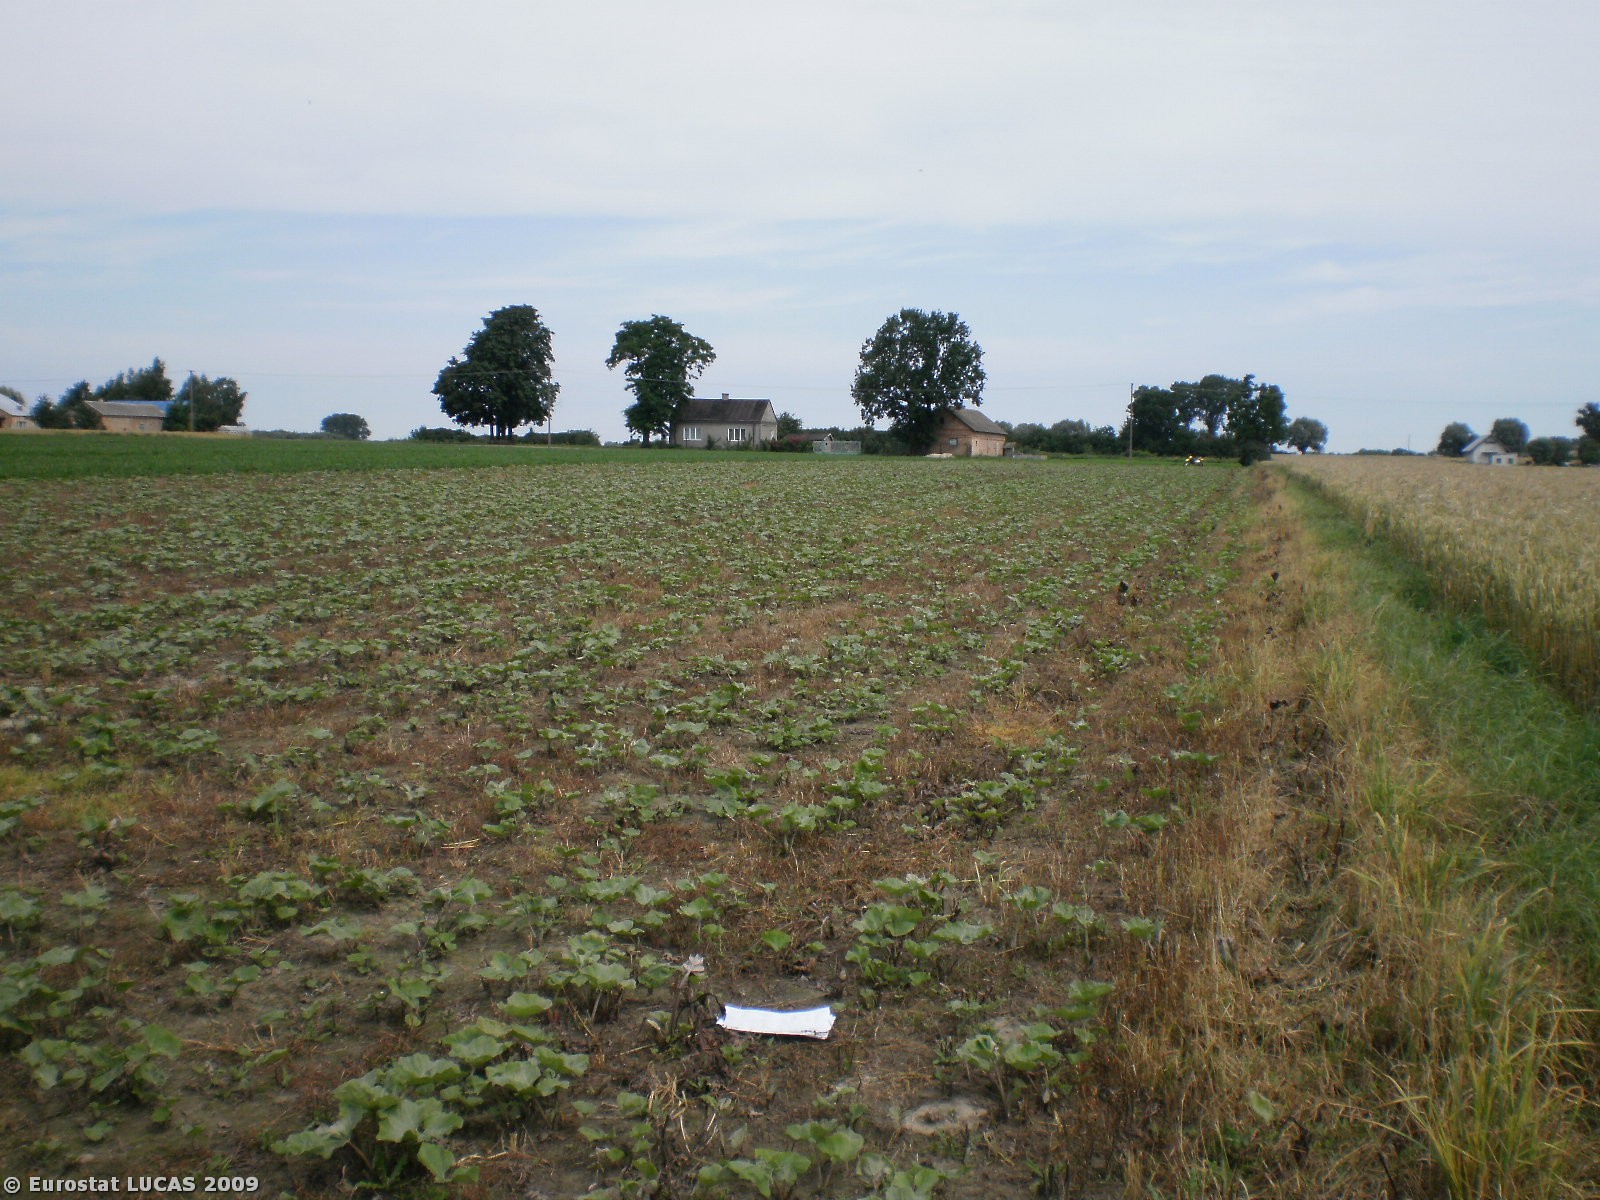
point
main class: Cropland
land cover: Other fresh vegetables
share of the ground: > 75 %
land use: Agriculture (excluding fallow land and kitchen gardens)
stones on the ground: < 10 %
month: July
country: PL
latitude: 52.6500
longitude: 20.3386
